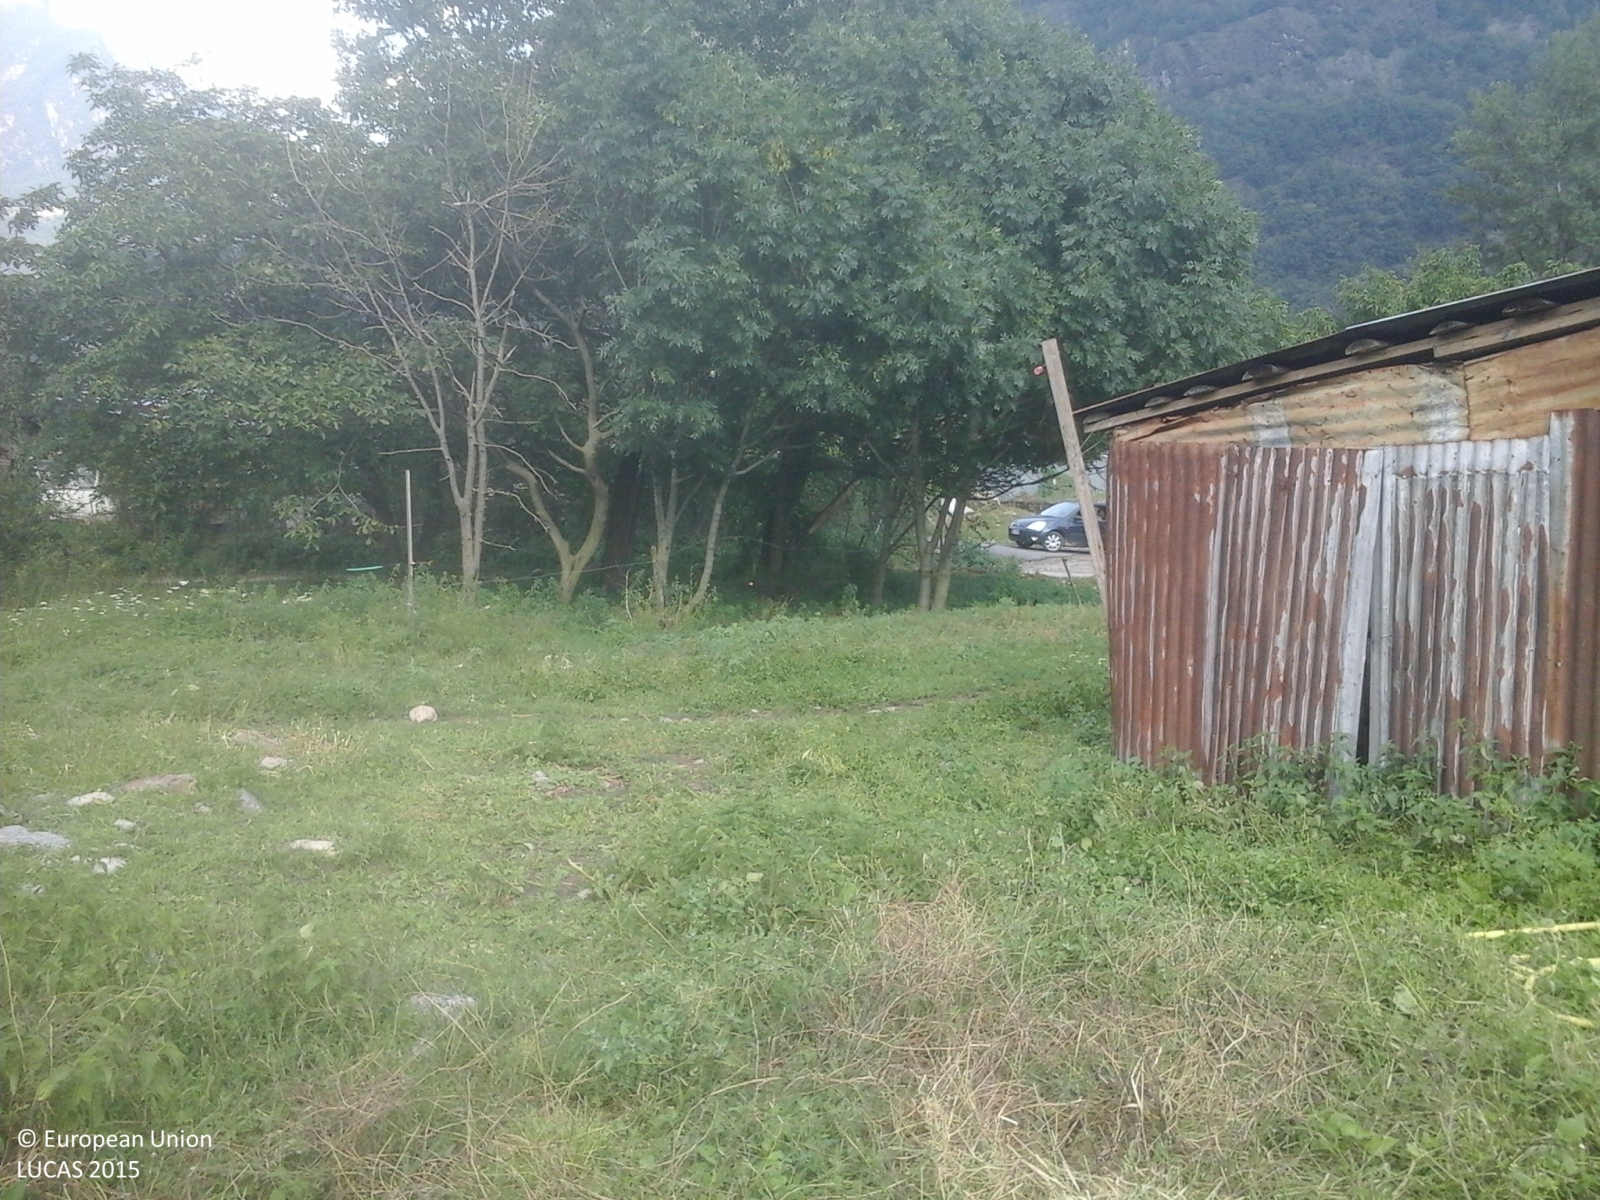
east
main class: Grassland
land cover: Grassland without tree/shrub cover
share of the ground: > 75 %
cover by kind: herbaceous plants 100 %
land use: Agriculture (excluding fallow land and kitchen gardens)
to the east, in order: Grassland without tree/shrub cover; Broadleaved woodland; Artificial constructions in urban areas; Grassland without tree/shrub cover; Artificial constructions in urban areas
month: July
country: IT
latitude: 46.3134
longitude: 9.3905
